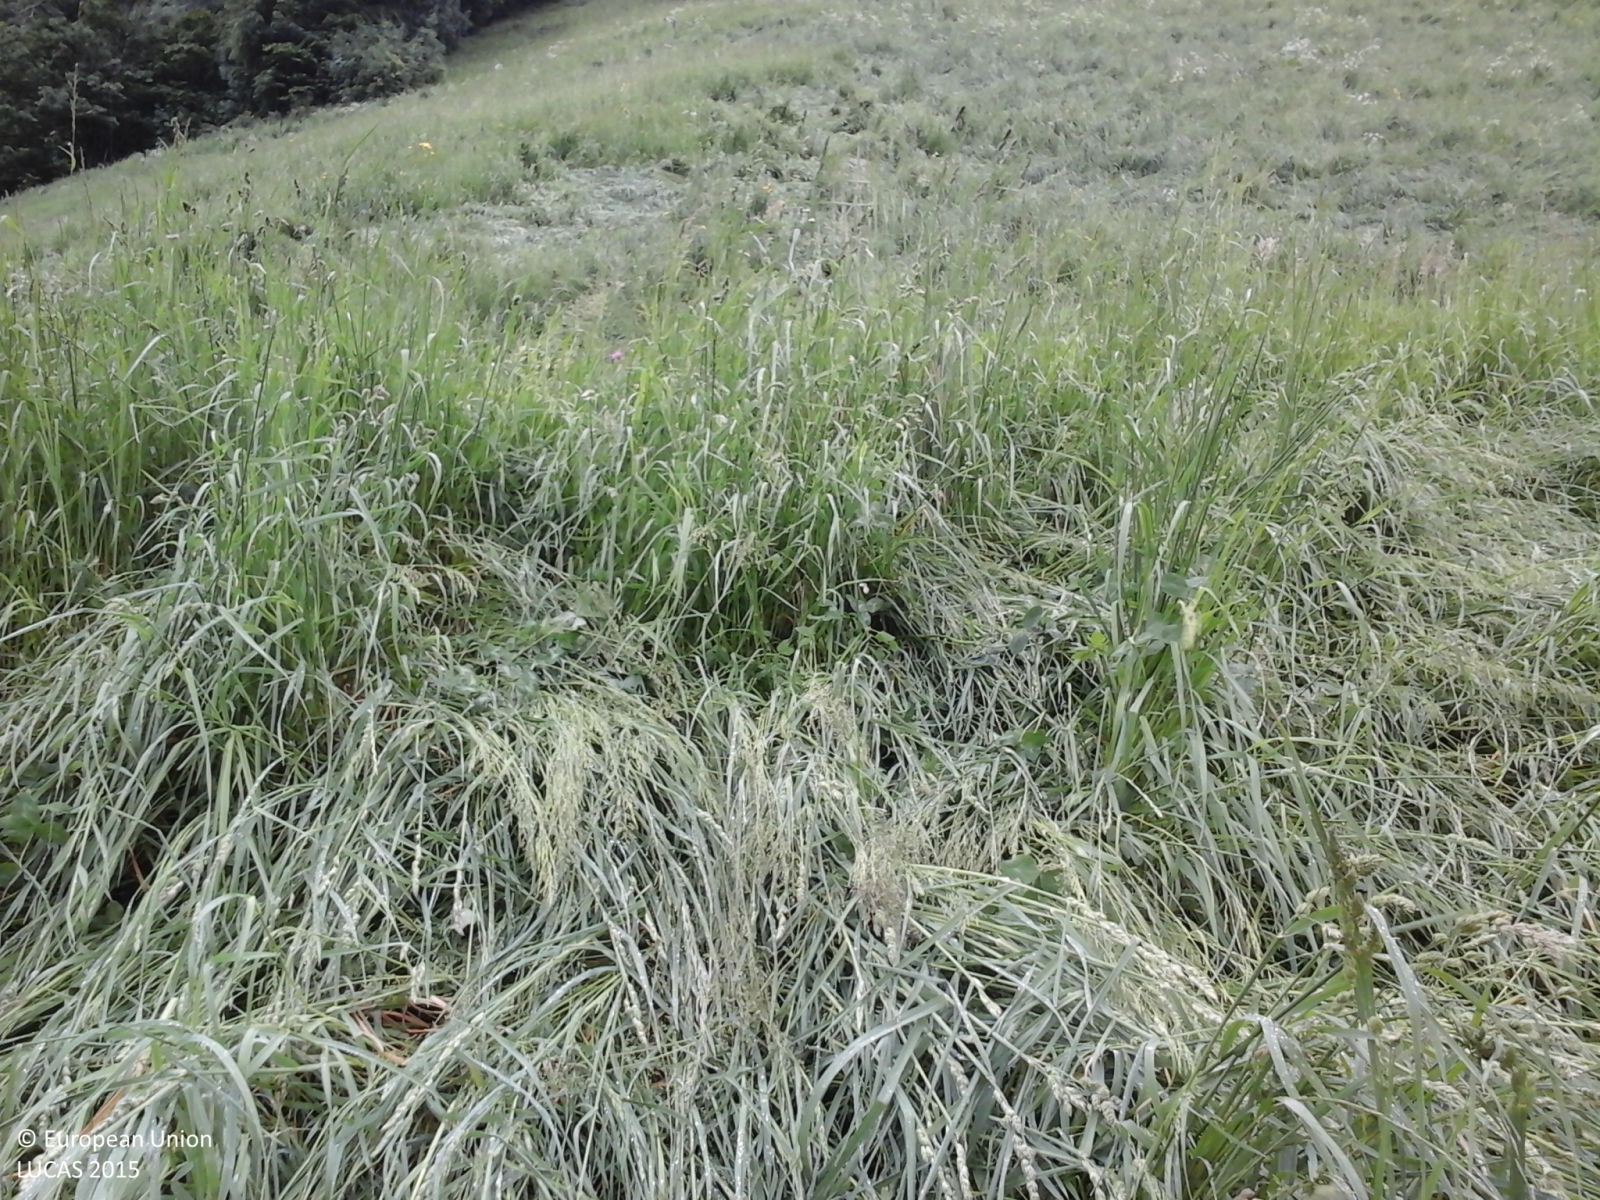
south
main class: Grassland
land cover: Grassland without tree/shrub cover
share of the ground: > 75 %
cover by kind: herbaceous plants 100 %
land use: Agriculture (excluding fallow land and kitchen gardens)
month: May
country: IT
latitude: 46.6522
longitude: 11.0572
